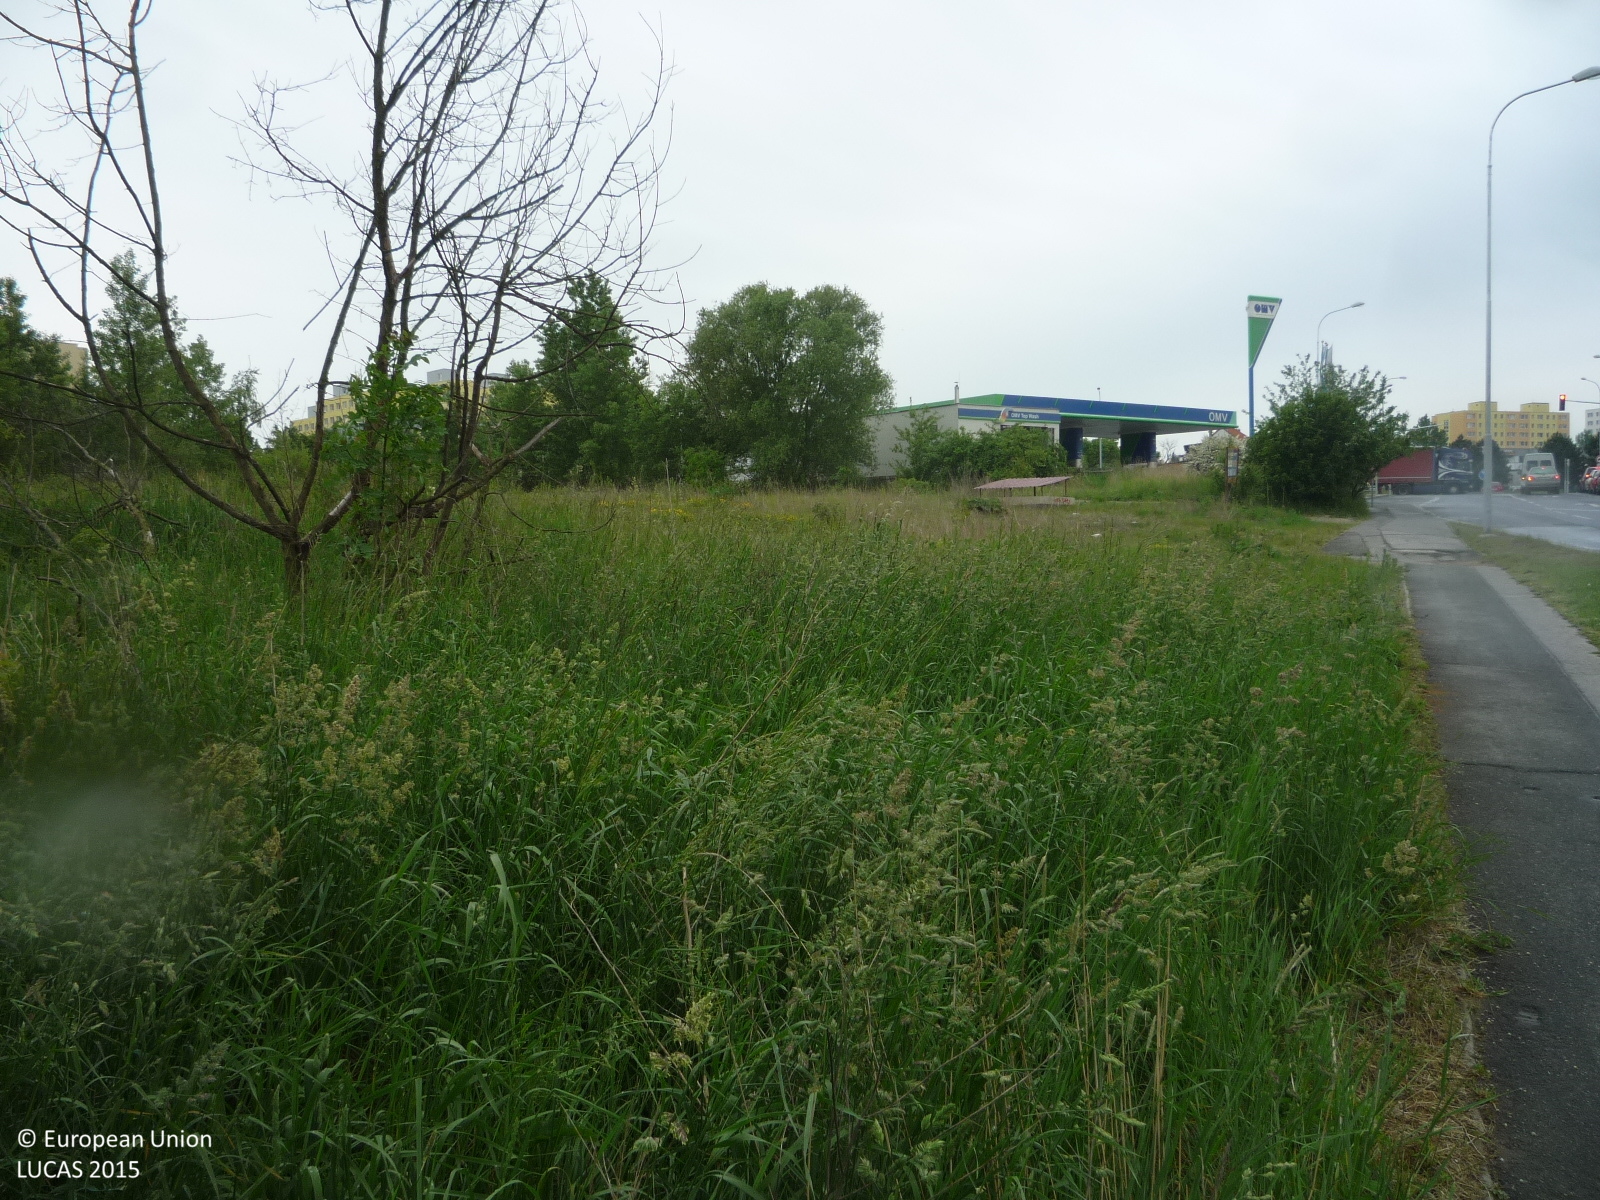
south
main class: Grassland
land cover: Grassland without tree/shrub cover
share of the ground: > 75 %
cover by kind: herbaceous plants 100 %
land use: Abandoned areas
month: May
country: CZ
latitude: 50.0410
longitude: 14.5118
